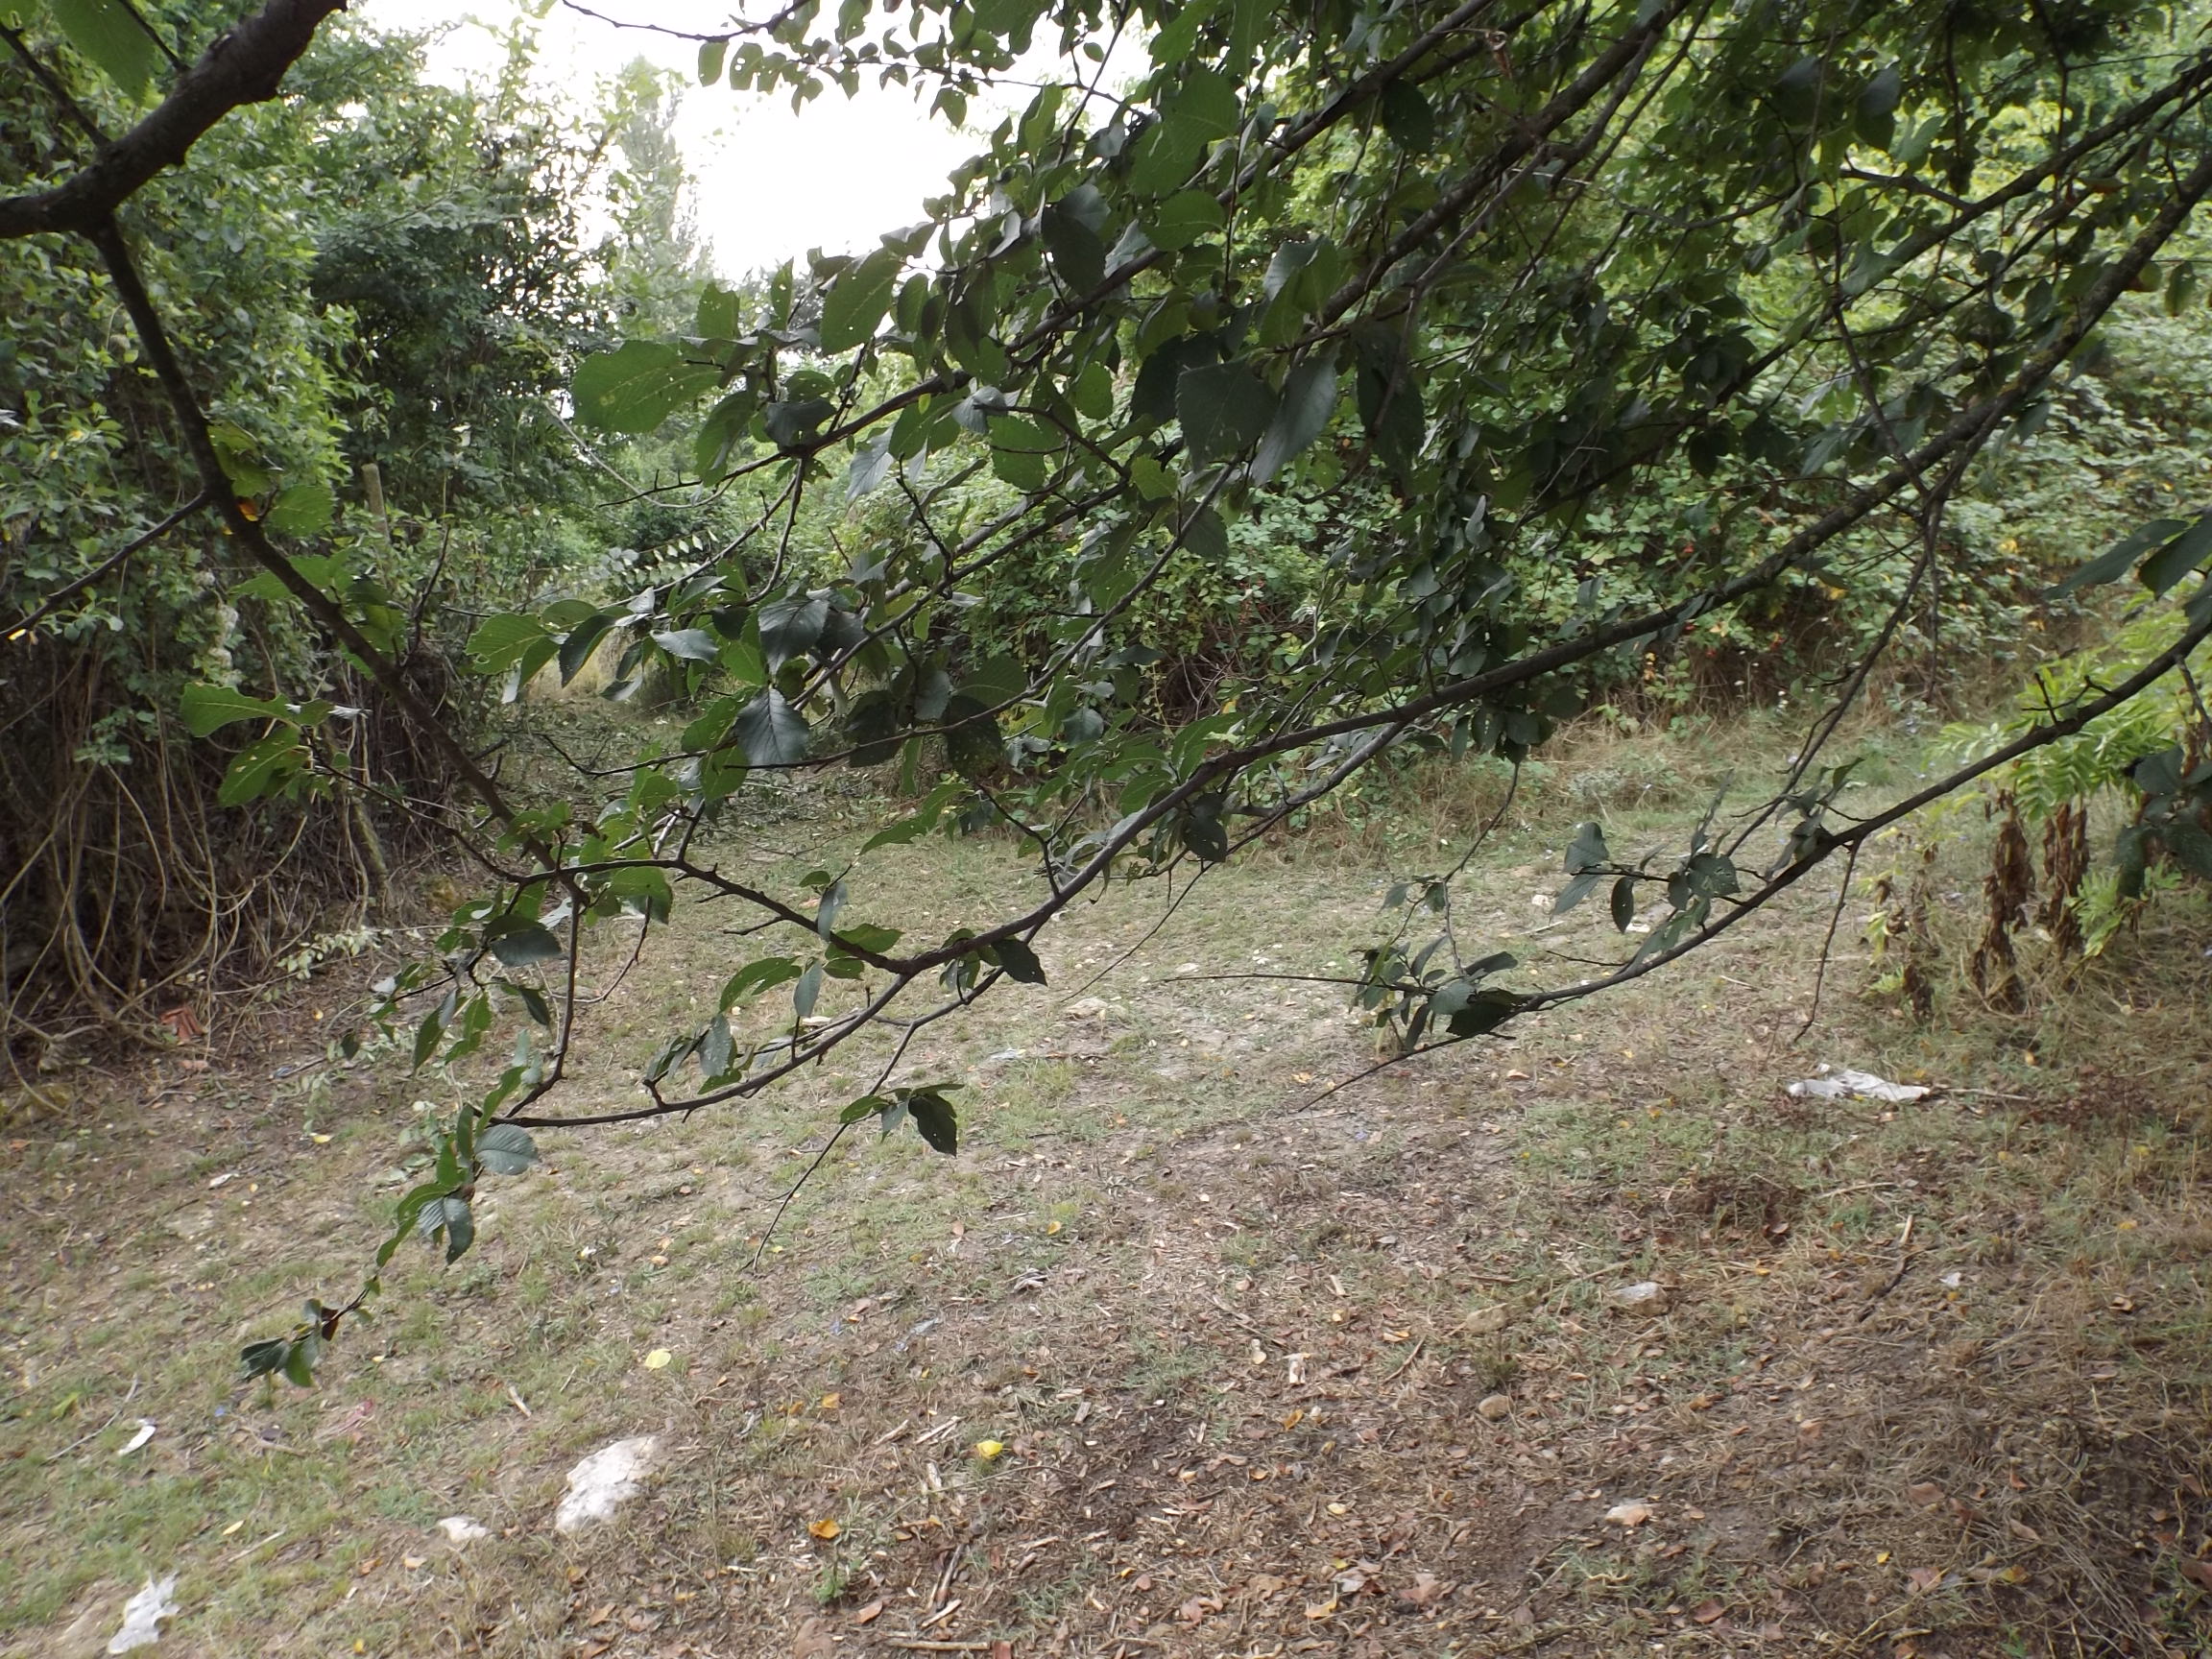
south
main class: Grassland
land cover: Grassland with sparse tree/shrub cover
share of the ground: > 75 %
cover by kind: herbaceous plants 90 %, broadleaved forest trees 5 %, shrubs 5 %
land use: Residential
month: August
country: BG
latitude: 43.1790
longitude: 27.5107
